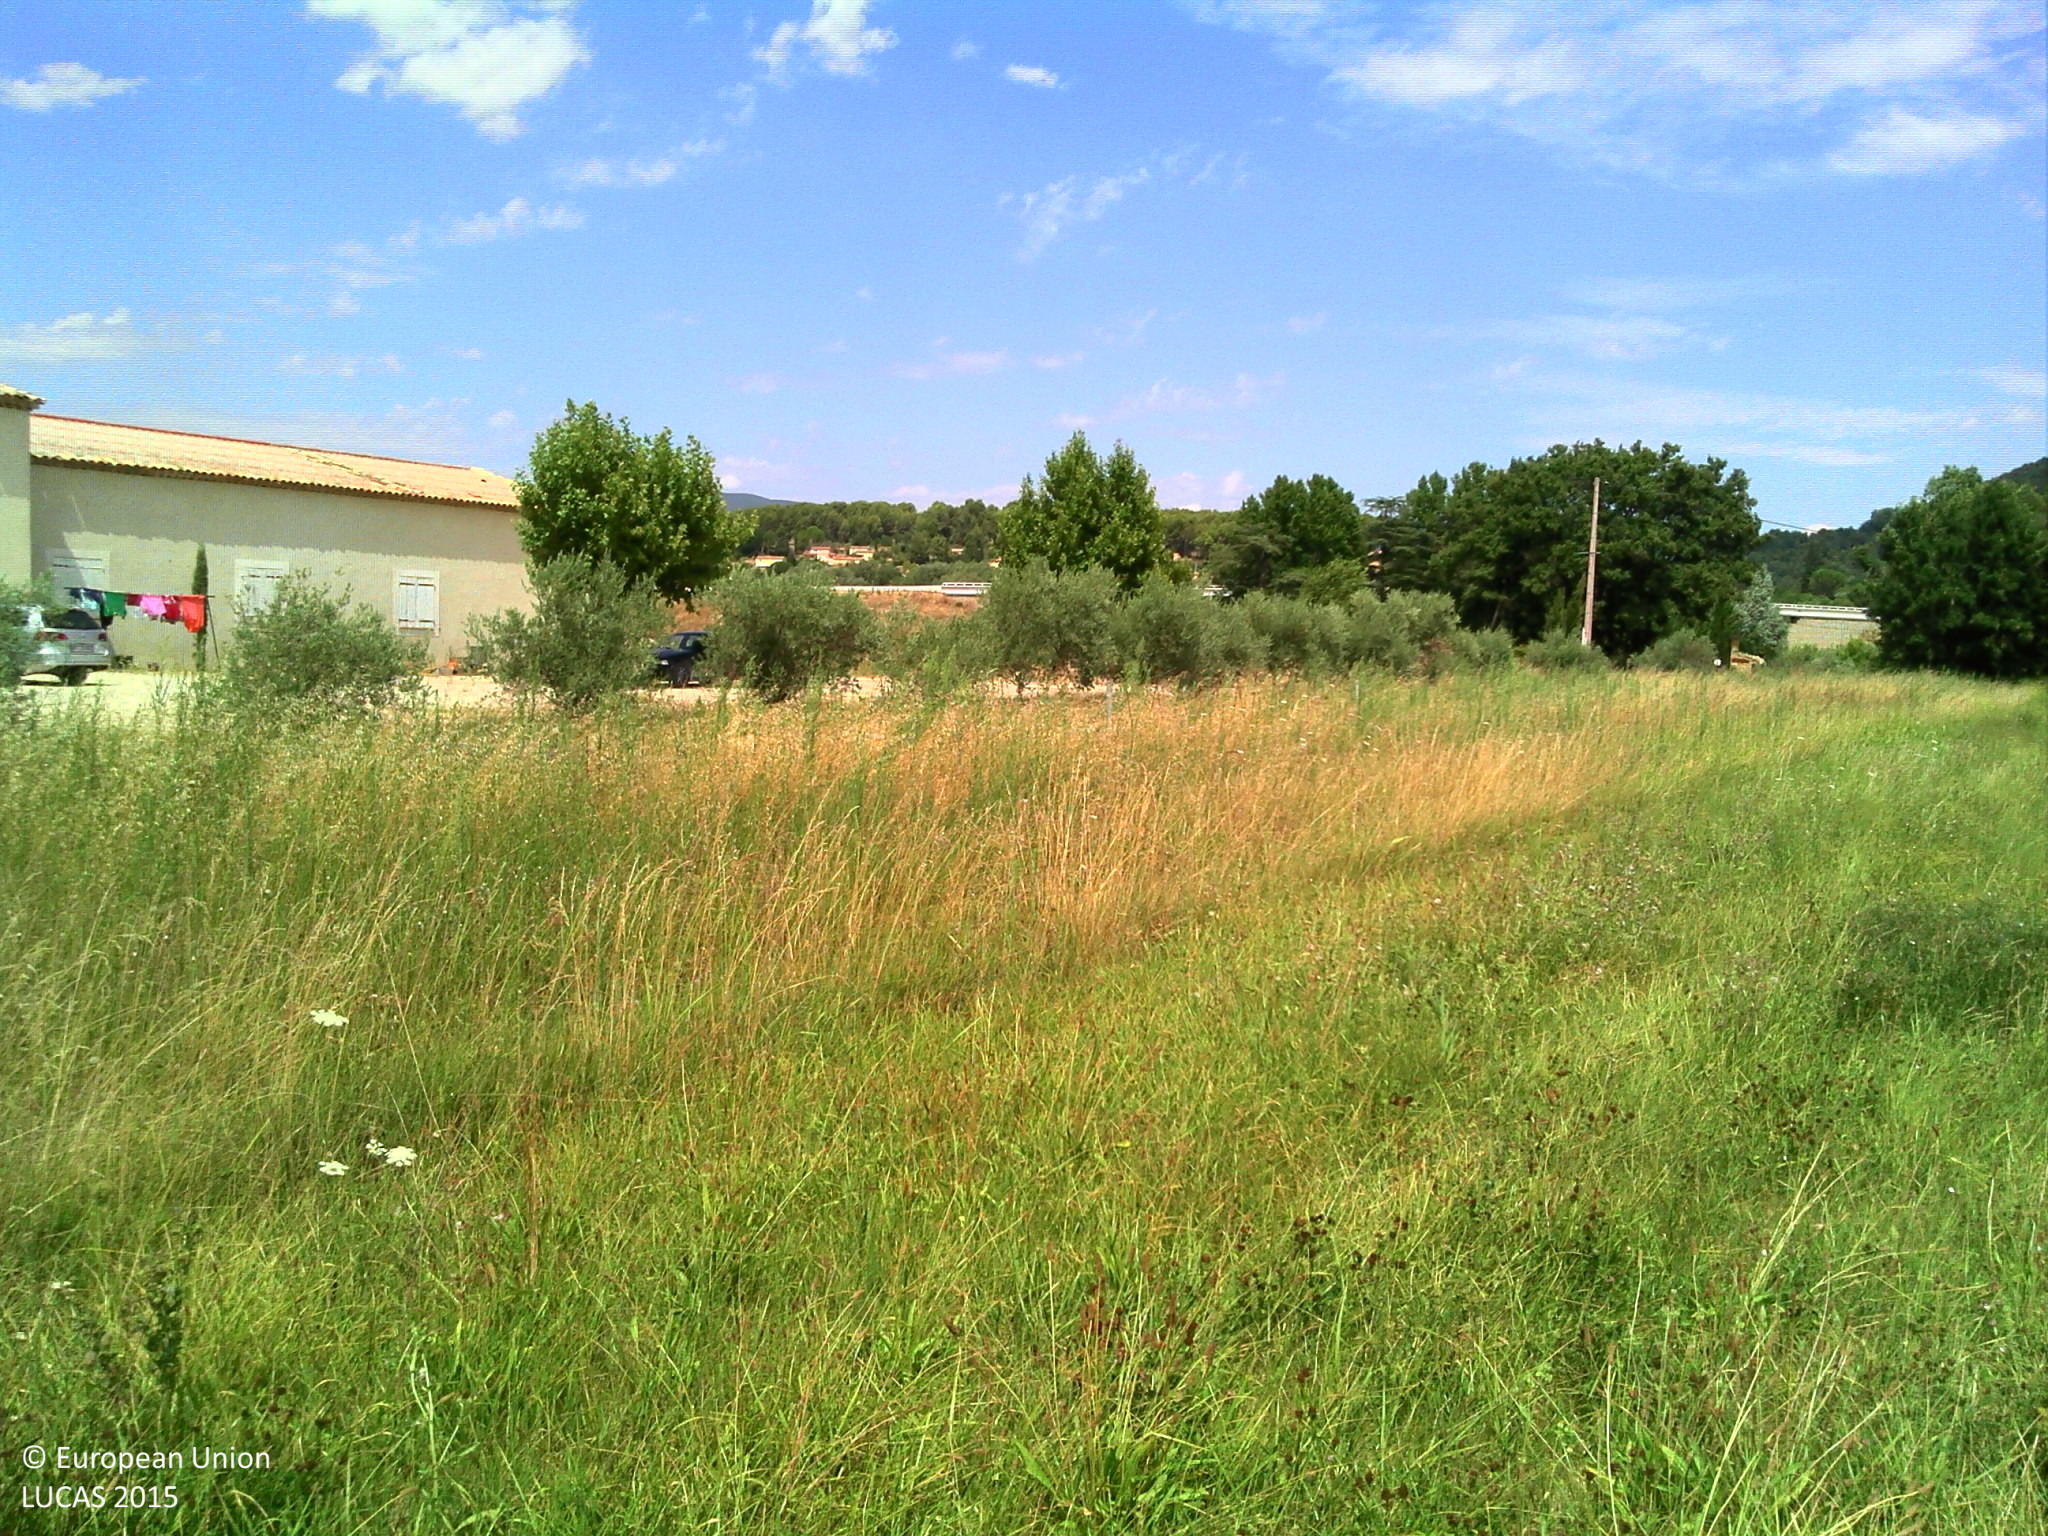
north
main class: Grassland
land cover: Grassland without tree/shrub cover
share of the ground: > 75 %
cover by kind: herbaceous plants 100 %
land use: Agriculture (excluding fallow land and kitchen gardens)
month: July
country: FR
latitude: 43.7237
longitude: 5.3789
